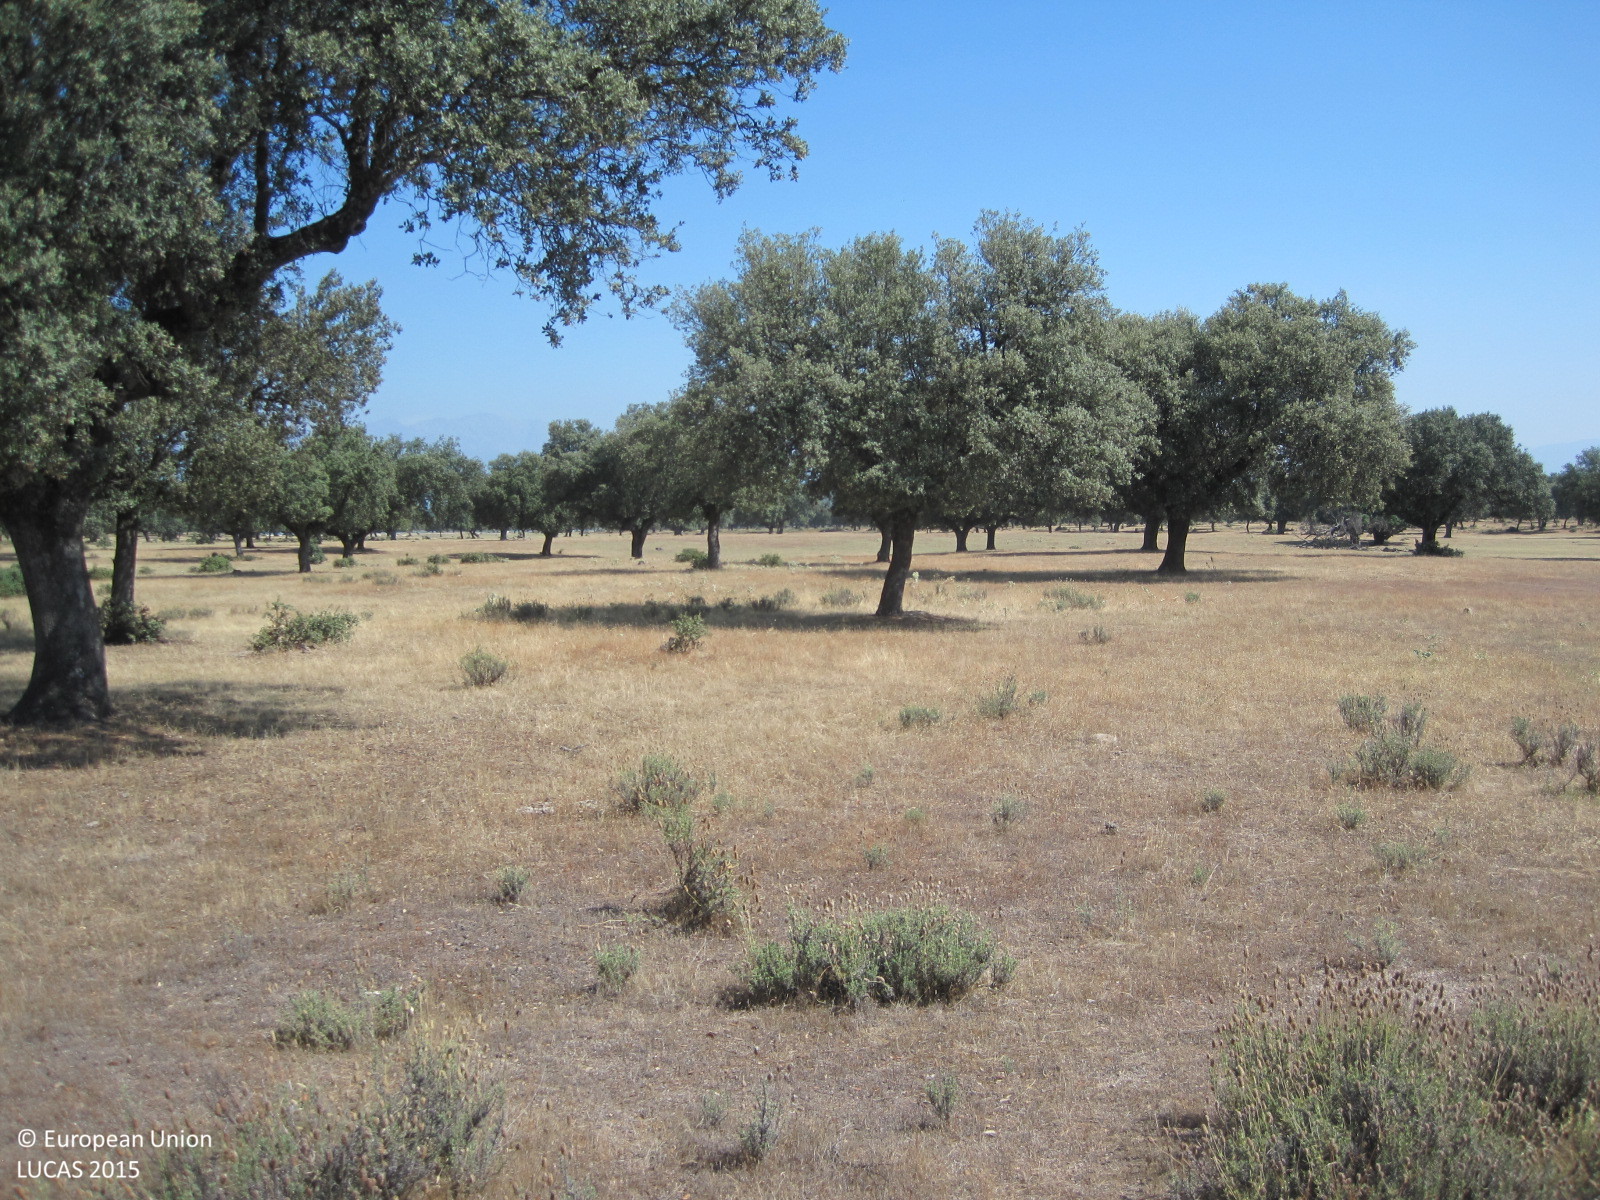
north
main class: Woodland
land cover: Broadleaved woodland
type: broadleaved evergreen forest
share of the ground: 25 - 50 %
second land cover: Grassland without tree/shrub cover
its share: > 75 %
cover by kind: herbaceous plants 65 %, broadleaved forest trees 35 %
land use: Forestry
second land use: Agriculture (excluding fallow land and kitchen gardens)
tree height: > 5 m
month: July
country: ES
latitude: 40.0121
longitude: -5.0835
